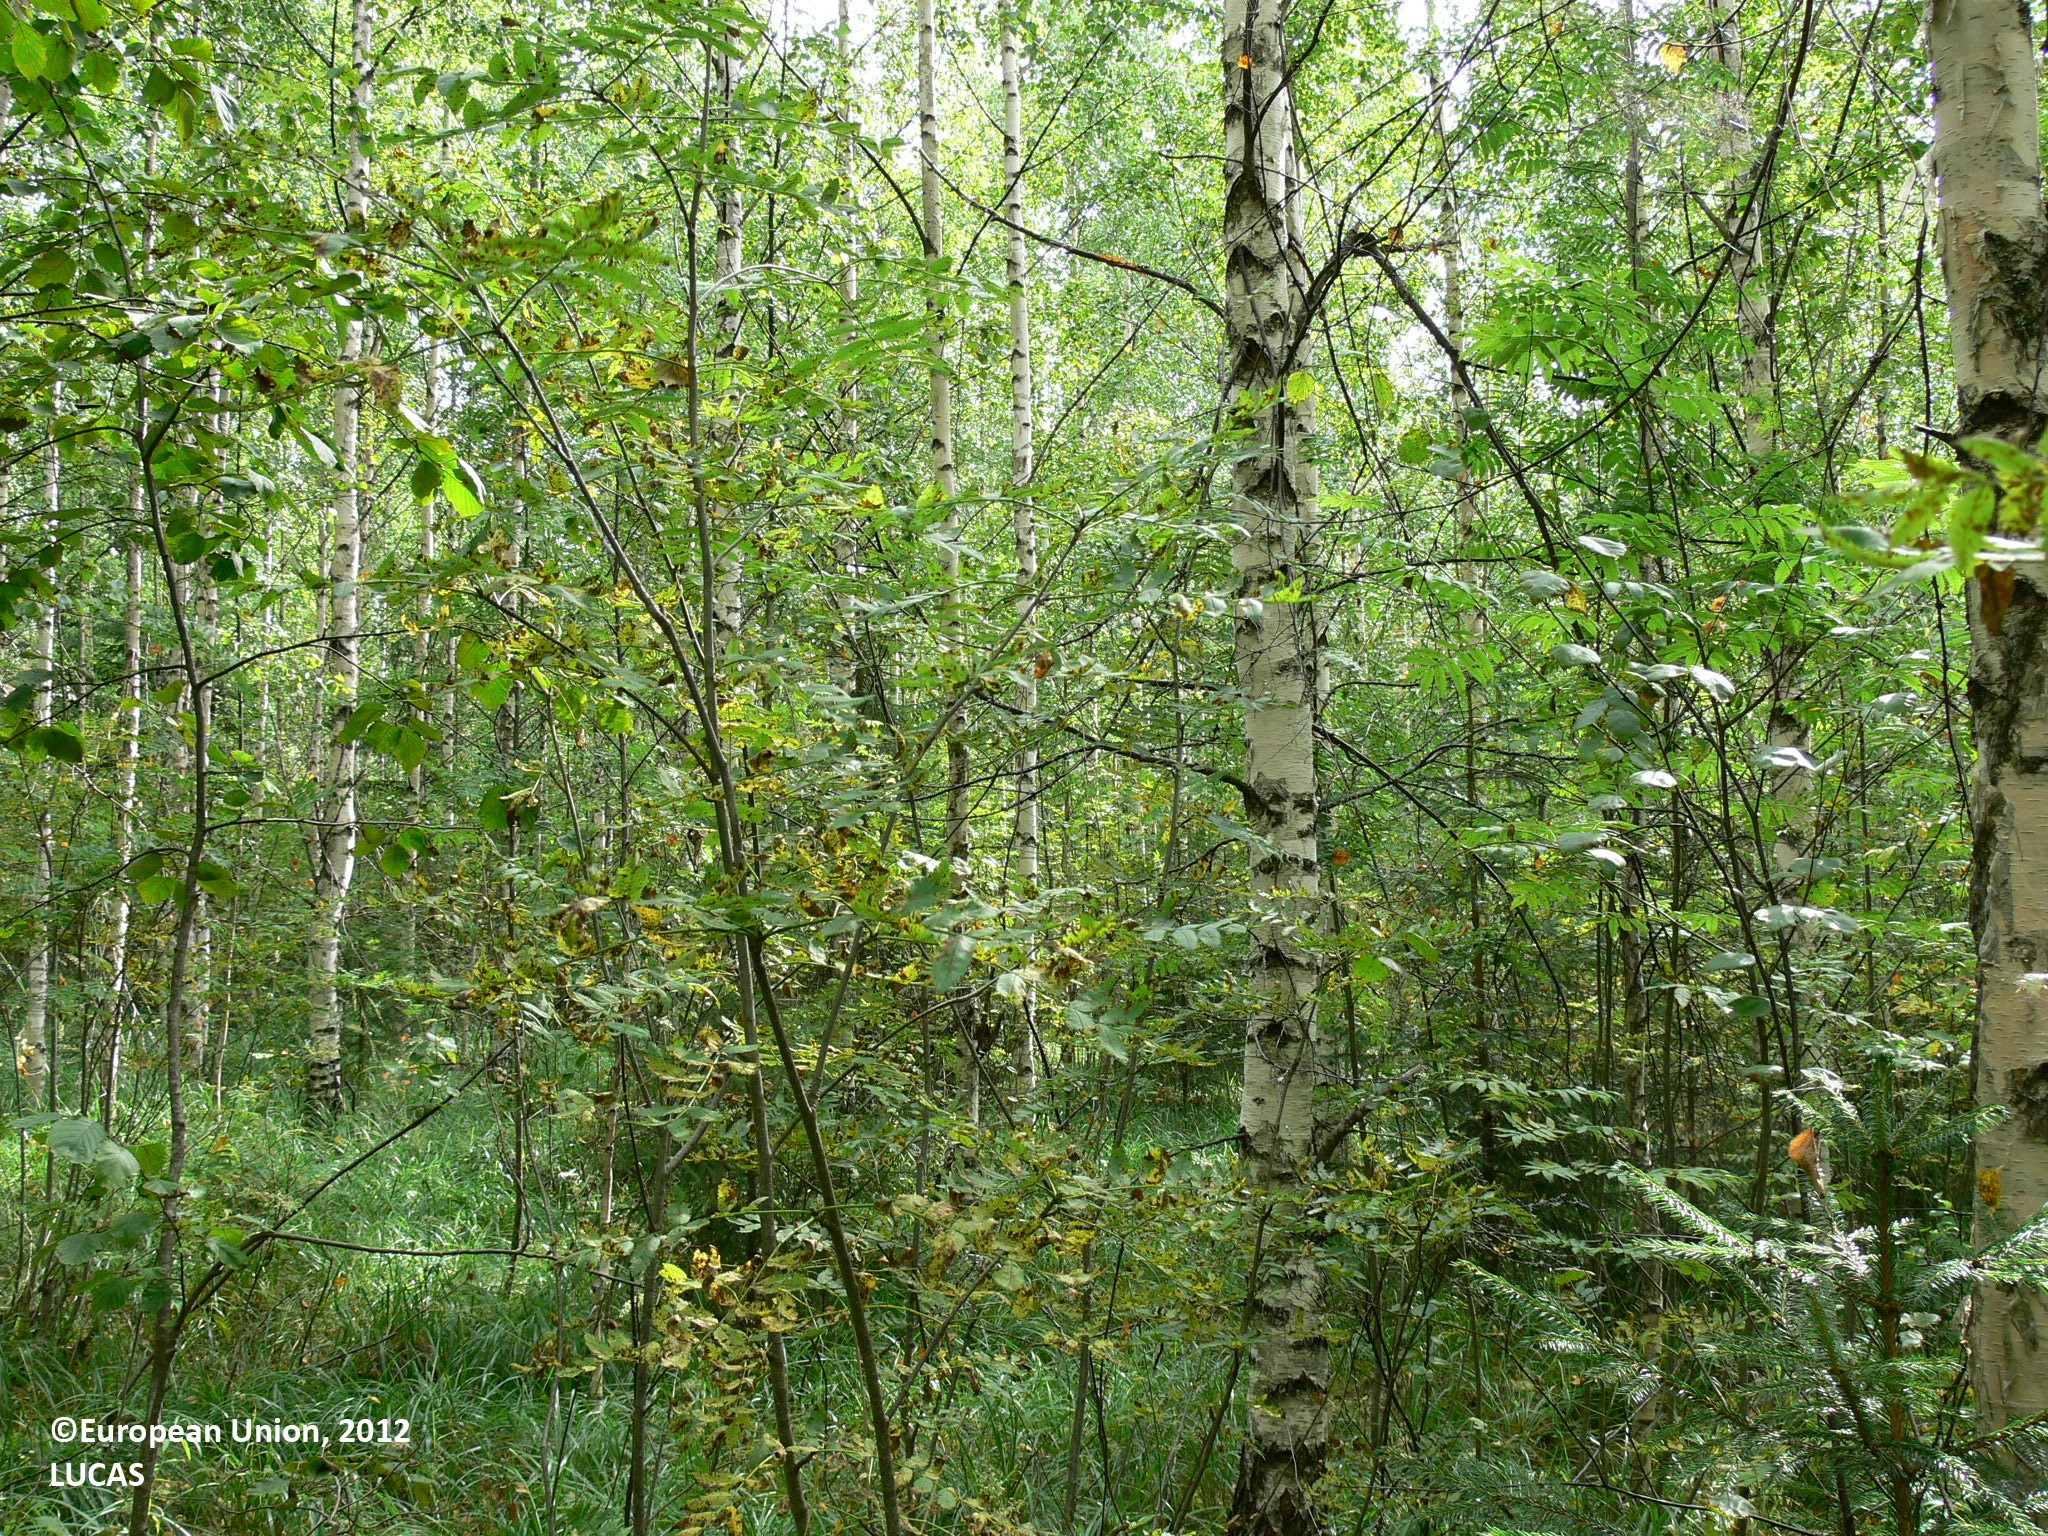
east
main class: Woodland
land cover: Broadleaved woodland
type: boreal forest
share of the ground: > 75 %
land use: Forestry
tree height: > 5 m
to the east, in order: Broadleaved woodland; Spruce dominated mixed woodland; Broadleaved woodland; Spruce dominated mixed woodland; Ditches and canals; Spruce dominated mixed woodland; Pine dominated coniferous woodland; Pine dominated mixed woodland
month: August
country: FI
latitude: 62.4422
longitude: 30.6941
